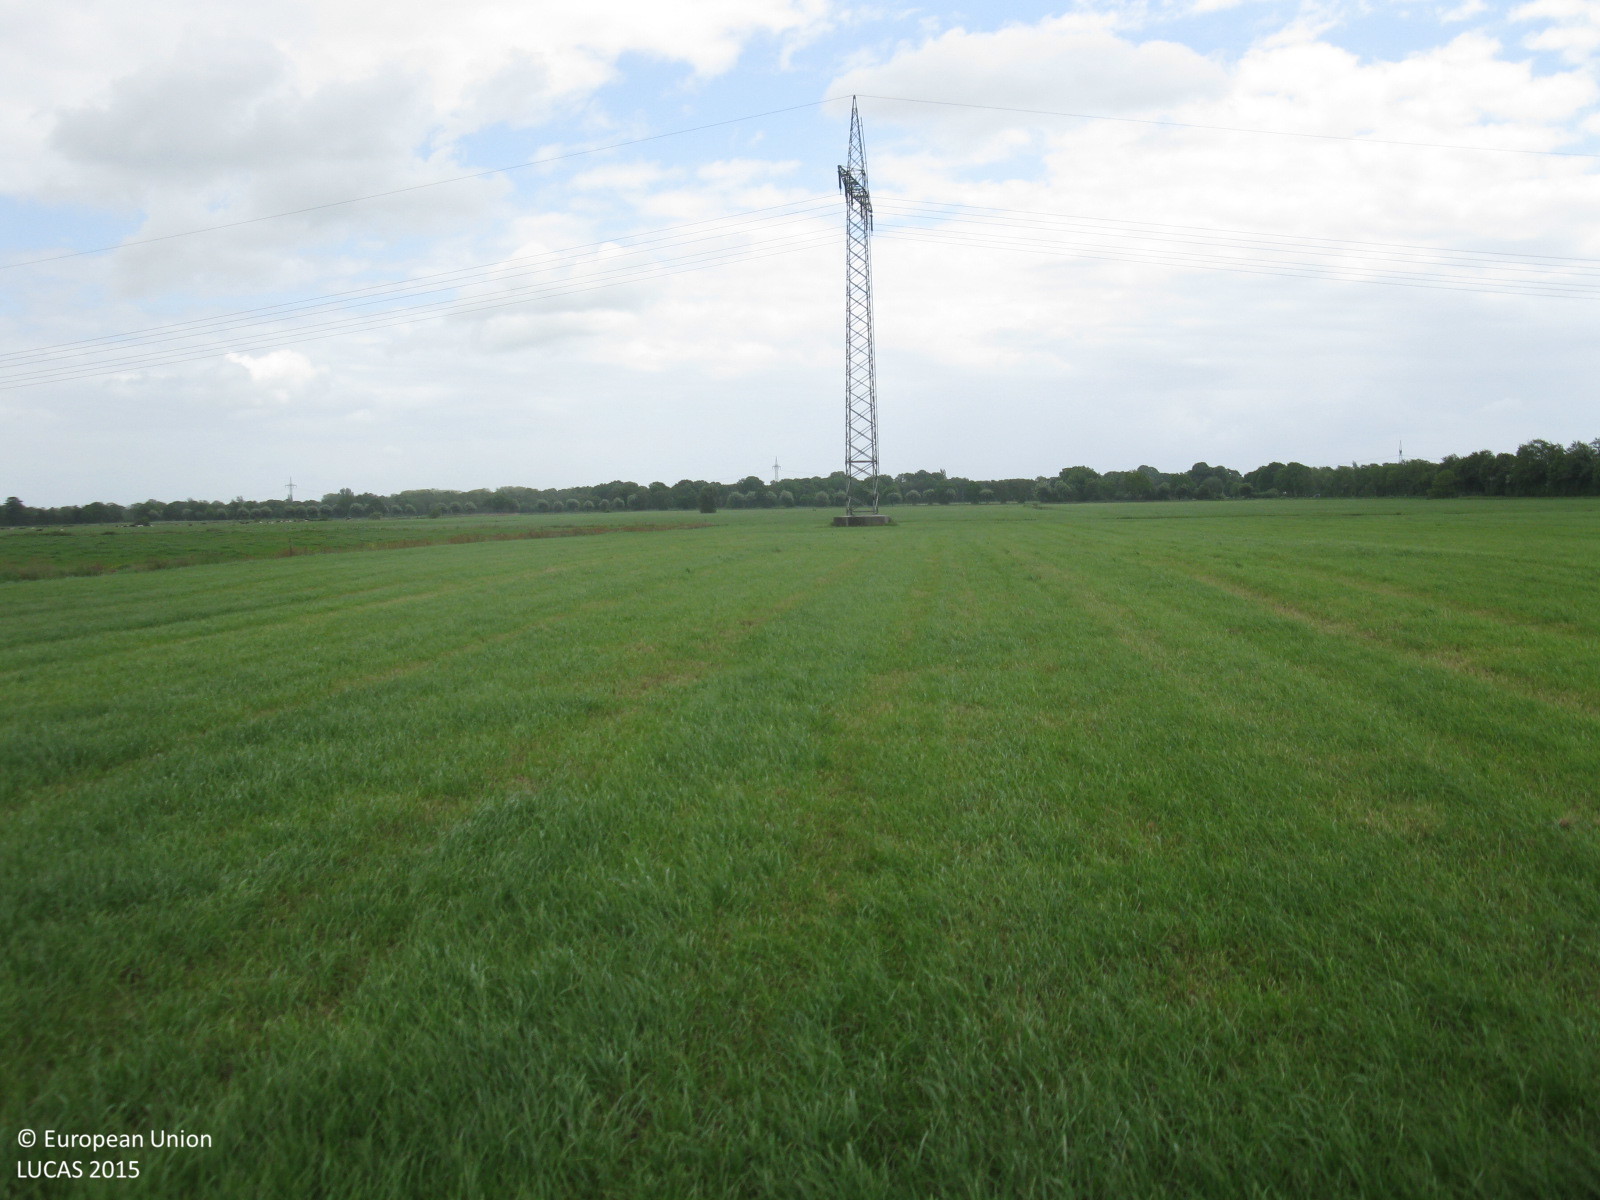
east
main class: Grassland
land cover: Grassland without tree/shrub cover
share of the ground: > 75 %
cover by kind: herbaceous plants 100 %
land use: Agriculture (excluding fallow land and kitchen gardens)
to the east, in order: Grassland without tree/shrub cover; Electric lines; Grassland without tree/shrub cover; Inland fresh running water; Grassland without tree/shrub cover
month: June
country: DE
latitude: 53.1406
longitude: 7.4143
